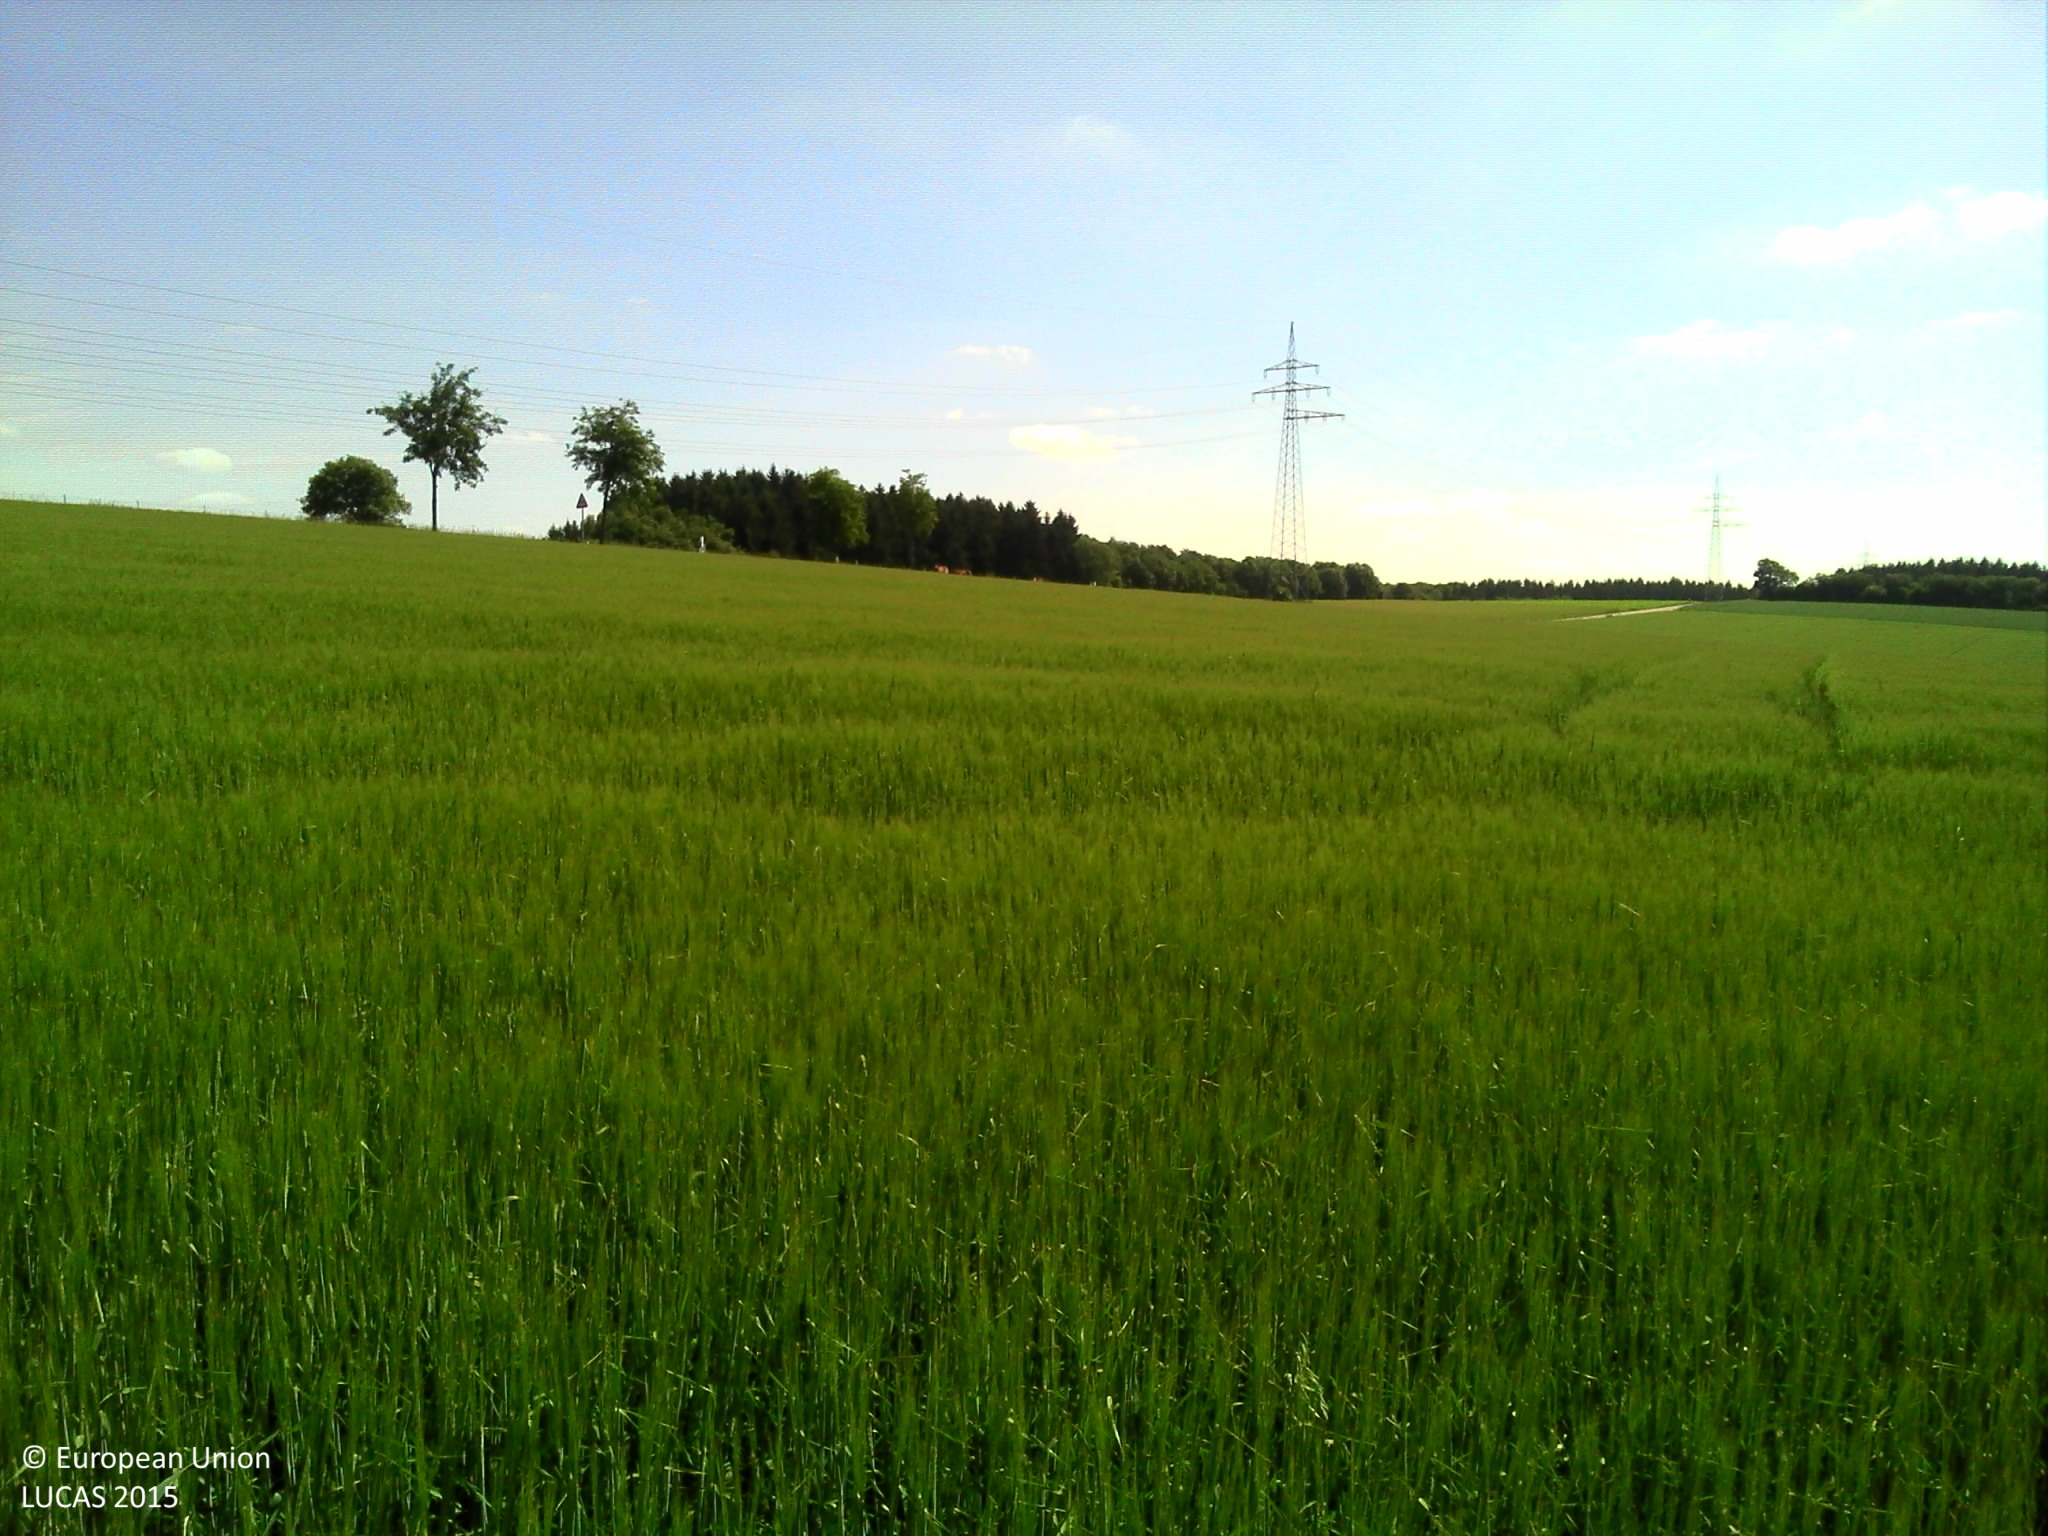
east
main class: Cropland
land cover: Barley
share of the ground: > 75 %
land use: Agriculture (excluding fallow land and kitchen gardens)
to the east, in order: Barley
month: June
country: LU
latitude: 49.9341
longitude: 6.0007
